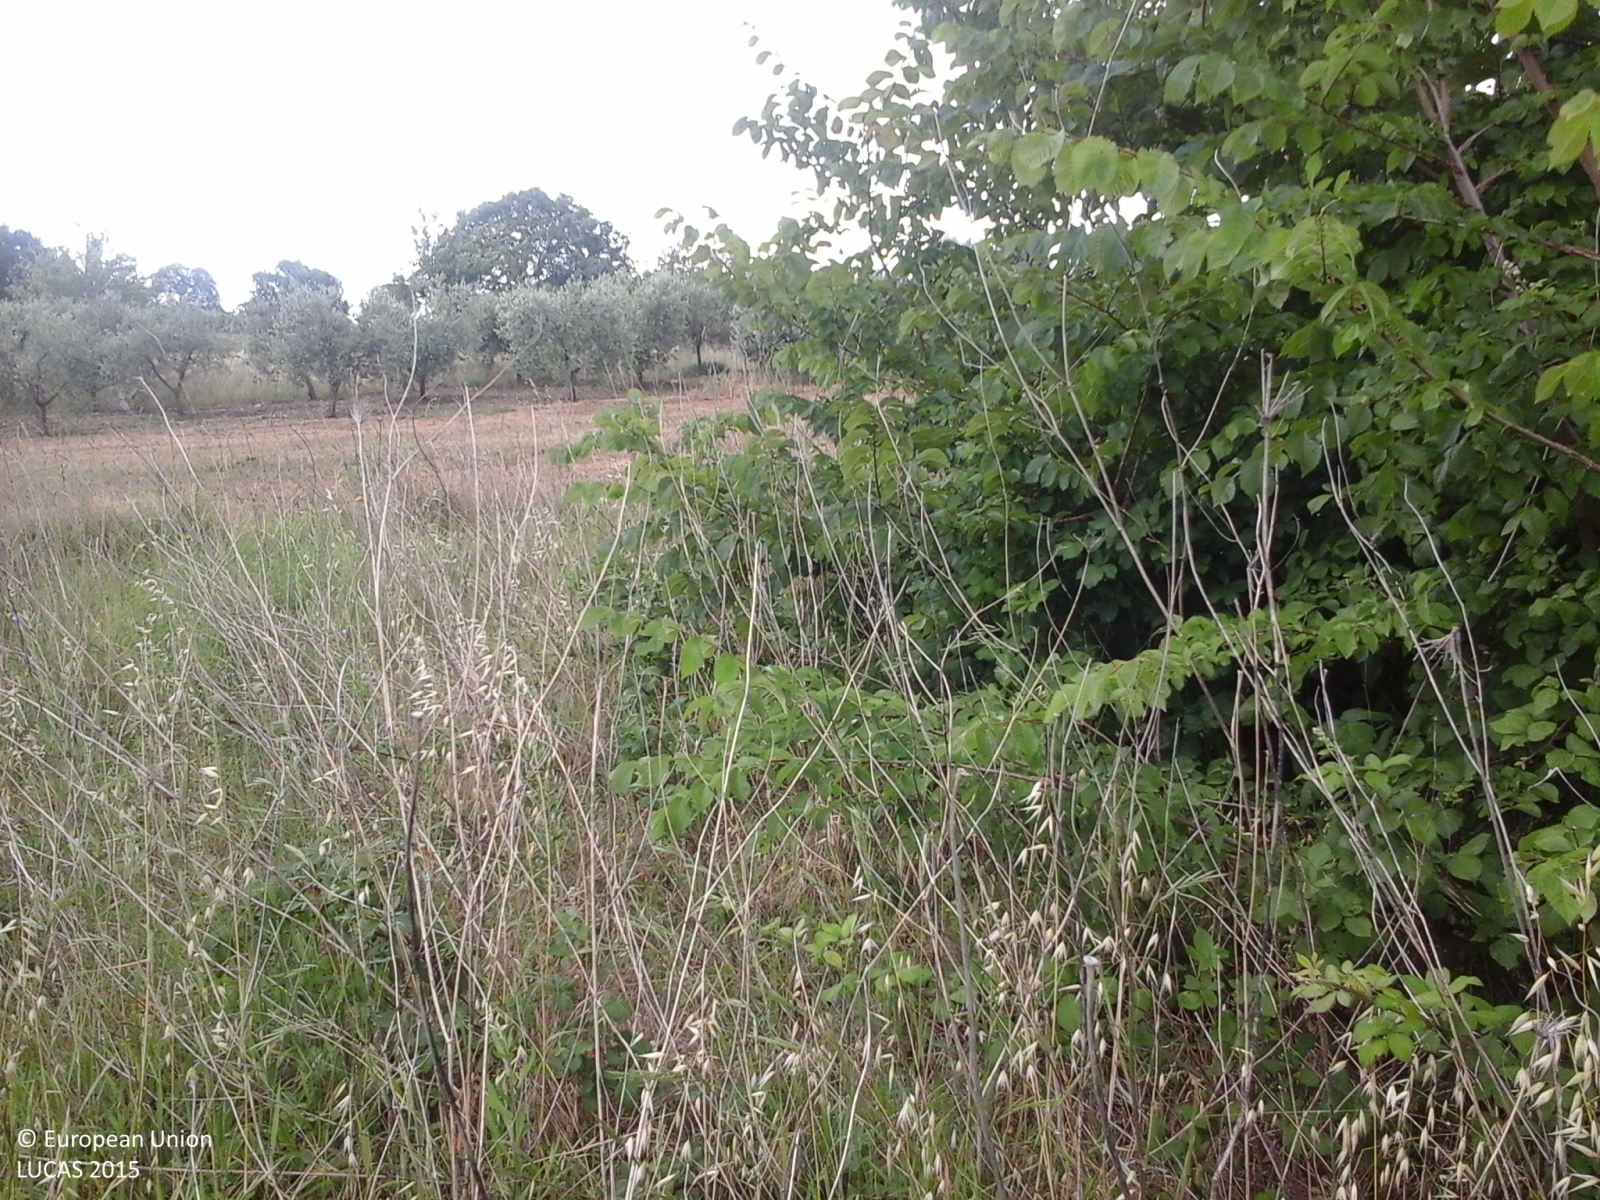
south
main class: Shrubland
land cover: Shrubland without tree cover
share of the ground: 50 - 75 %
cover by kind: shrubs 60 %, herbaceous plants 40 %
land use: Fallow land
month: June
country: IT
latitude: 41.0237
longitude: 15.0828
